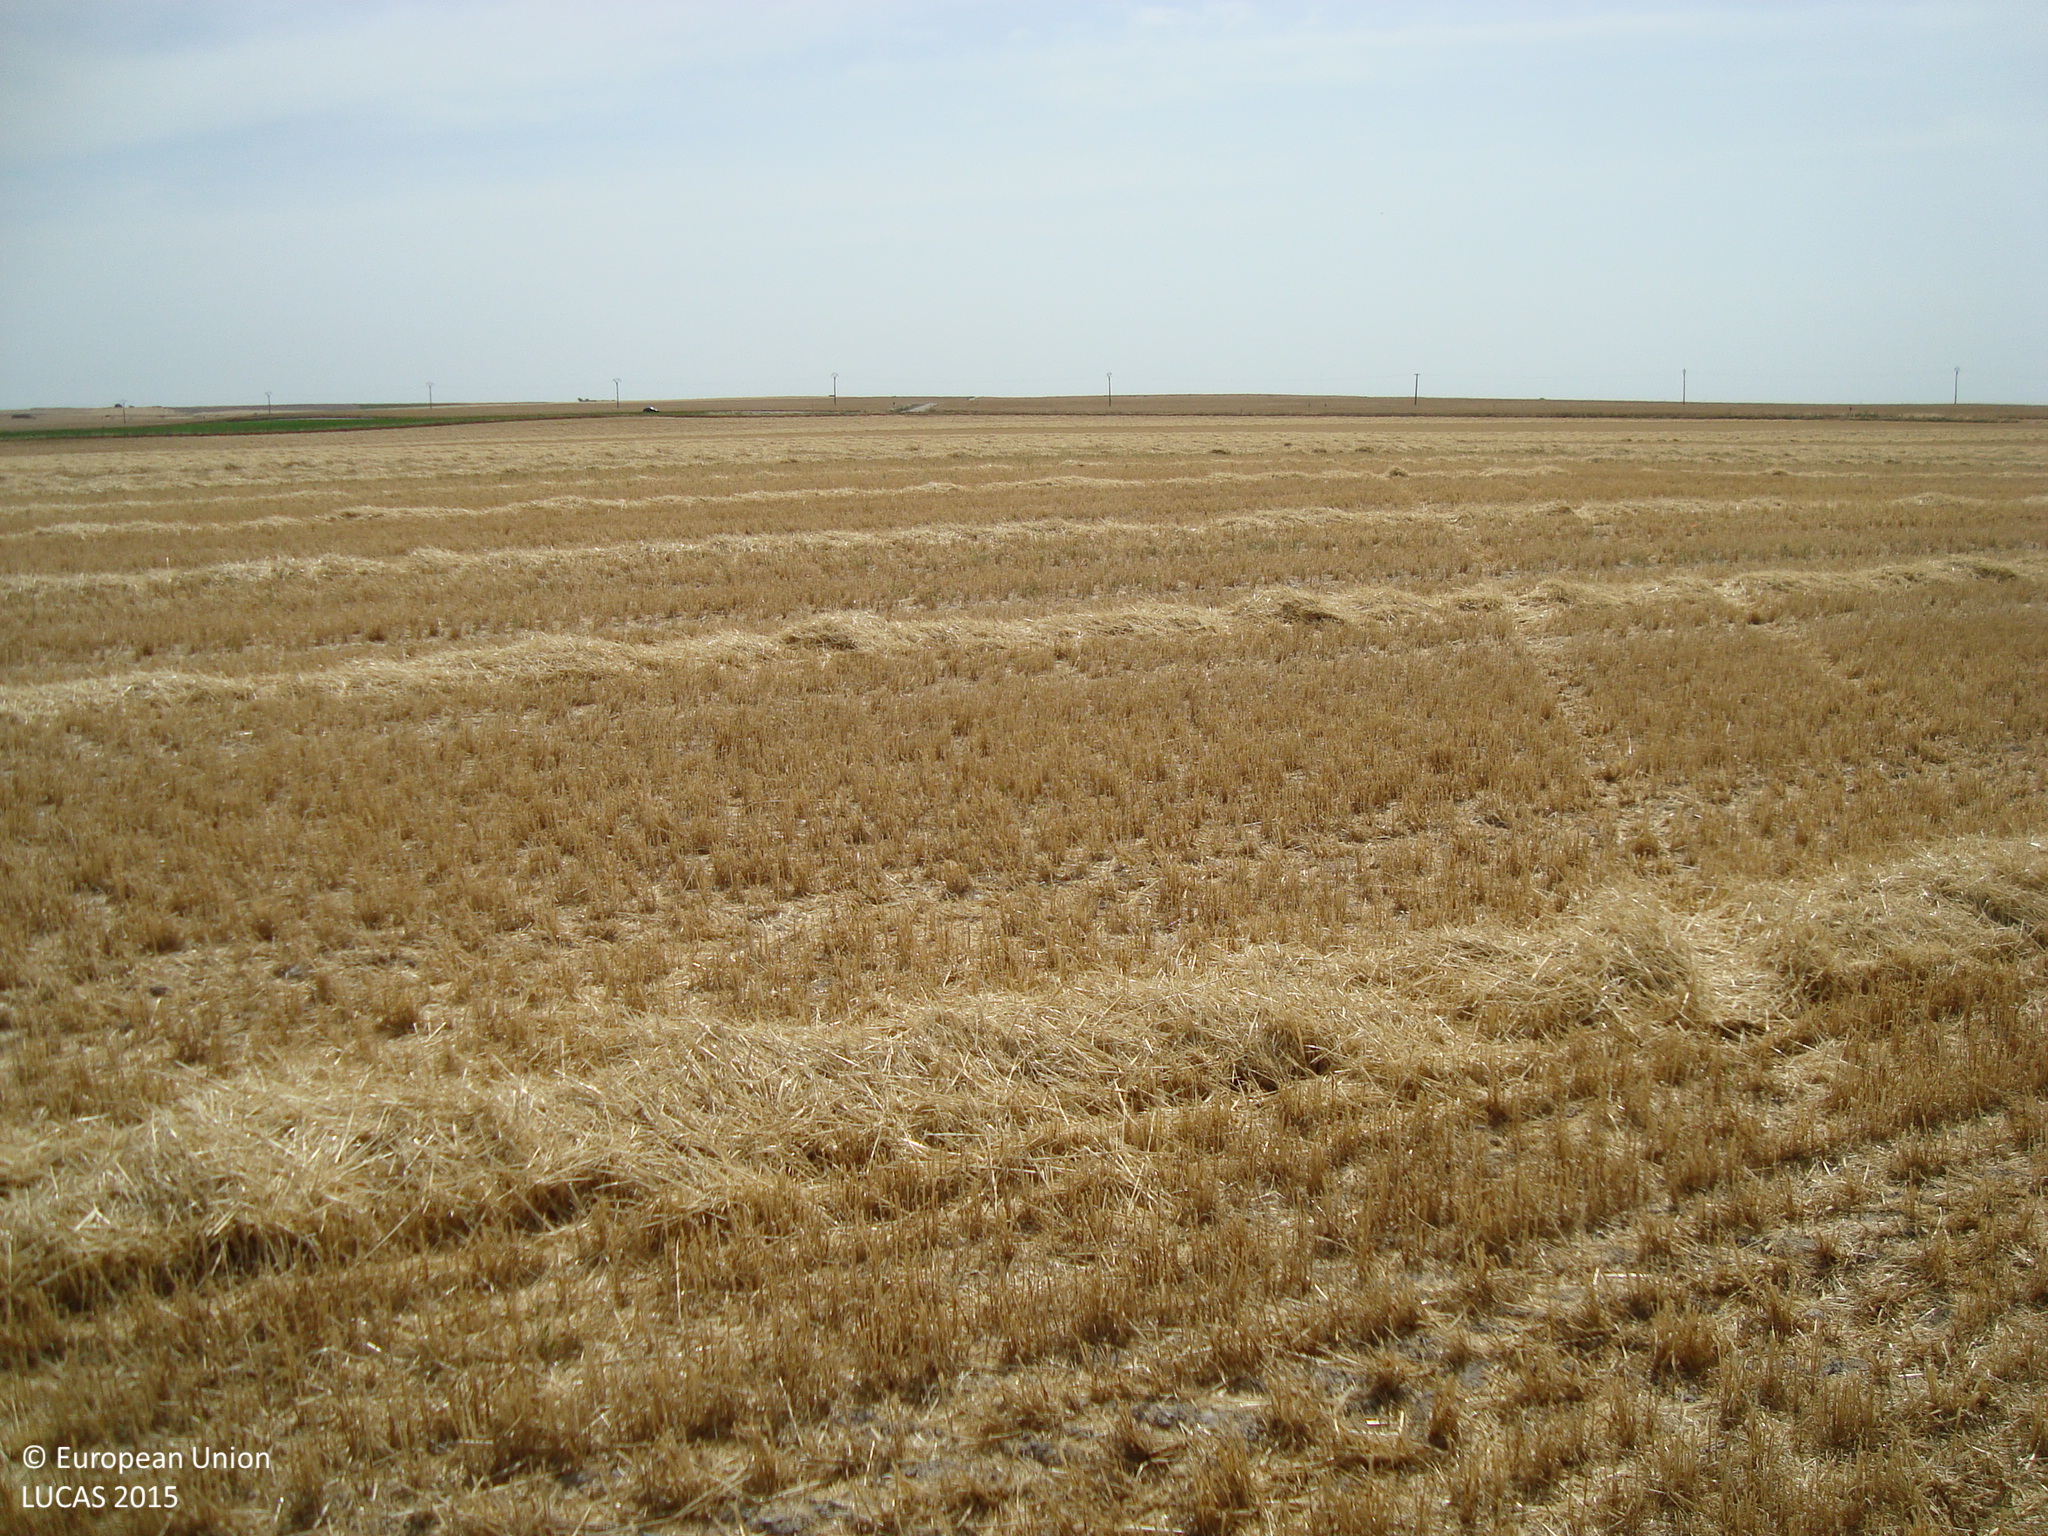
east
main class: Cropland
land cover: Barley
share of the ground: < 10 %
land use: Agriculture (excluding fallow land and kitchen gardens)
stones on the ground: < 10 %
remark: Harvested field
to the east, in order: Barley
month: July
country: ES
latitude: 41.7122
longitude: -4.1340
